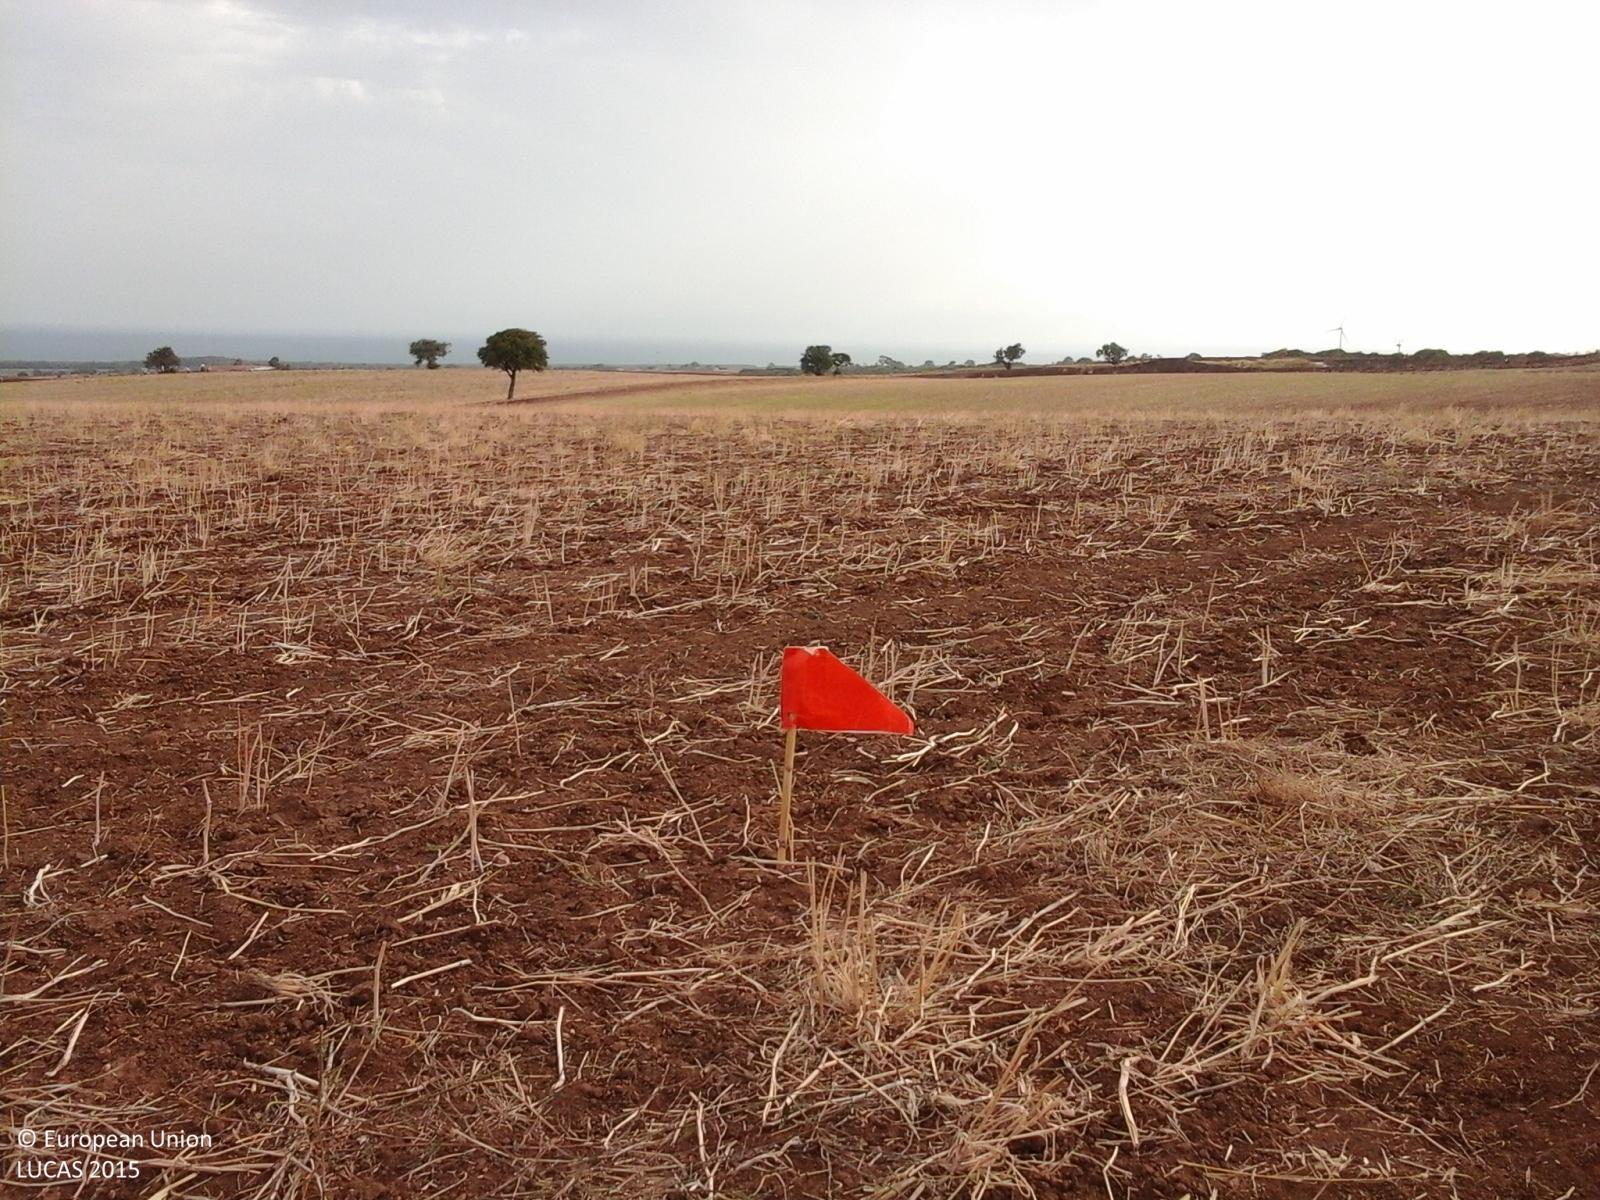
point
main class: Cropland
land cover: Other non-permanent industrial crops
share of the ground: > 75 %
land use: Agriculture (excluding fallow land and kitchen gardens)
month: September
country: IT
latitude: 41.8881
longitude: 15.1784
